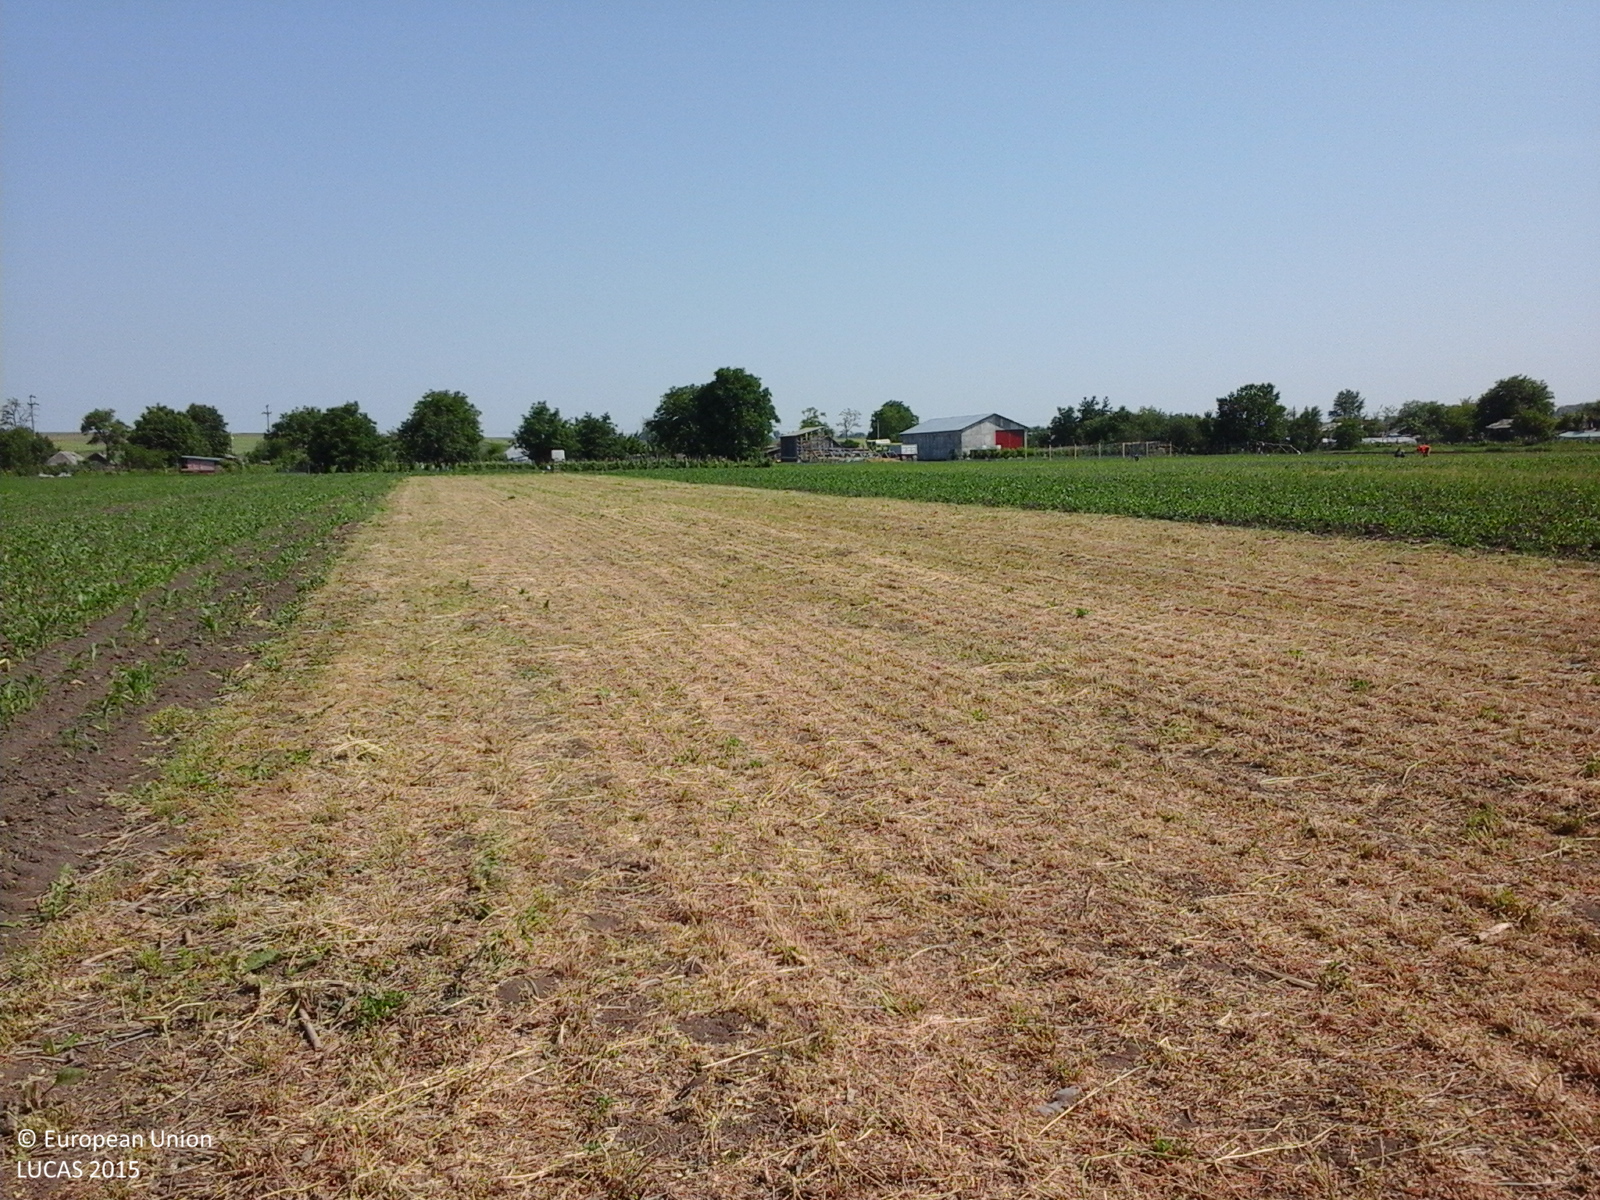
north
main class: Cropland
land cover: Lucerne
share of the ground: < 10 %
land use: Agriculture (excluding fallow land and kitchen gardens)
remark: Harvested field
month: June
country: RO
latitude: 46.8556
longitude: 26.8701
